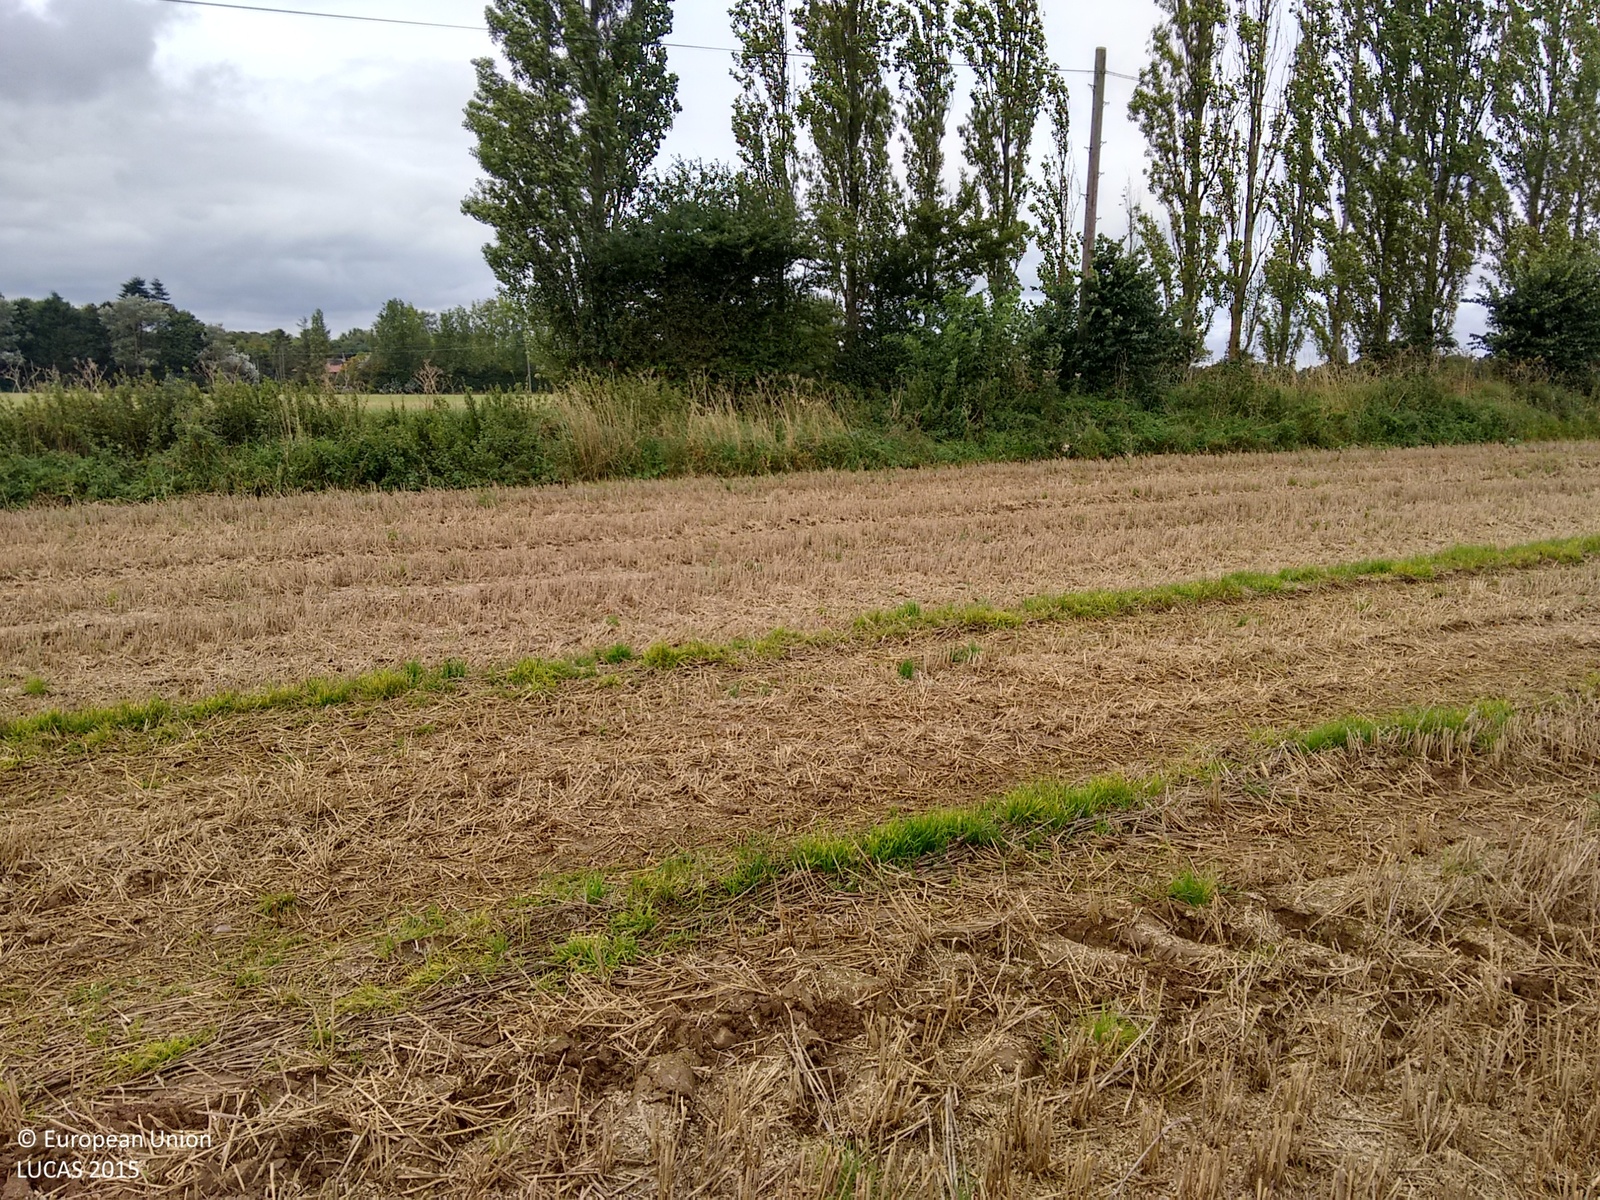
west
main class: Cropland
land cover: Common wheat
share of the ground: > 75 %
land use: Agriculture (excluding fallow land and kitchen gardens)
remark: Harvested field
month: September
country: GB
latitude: 52.6474
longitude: 1.4524
